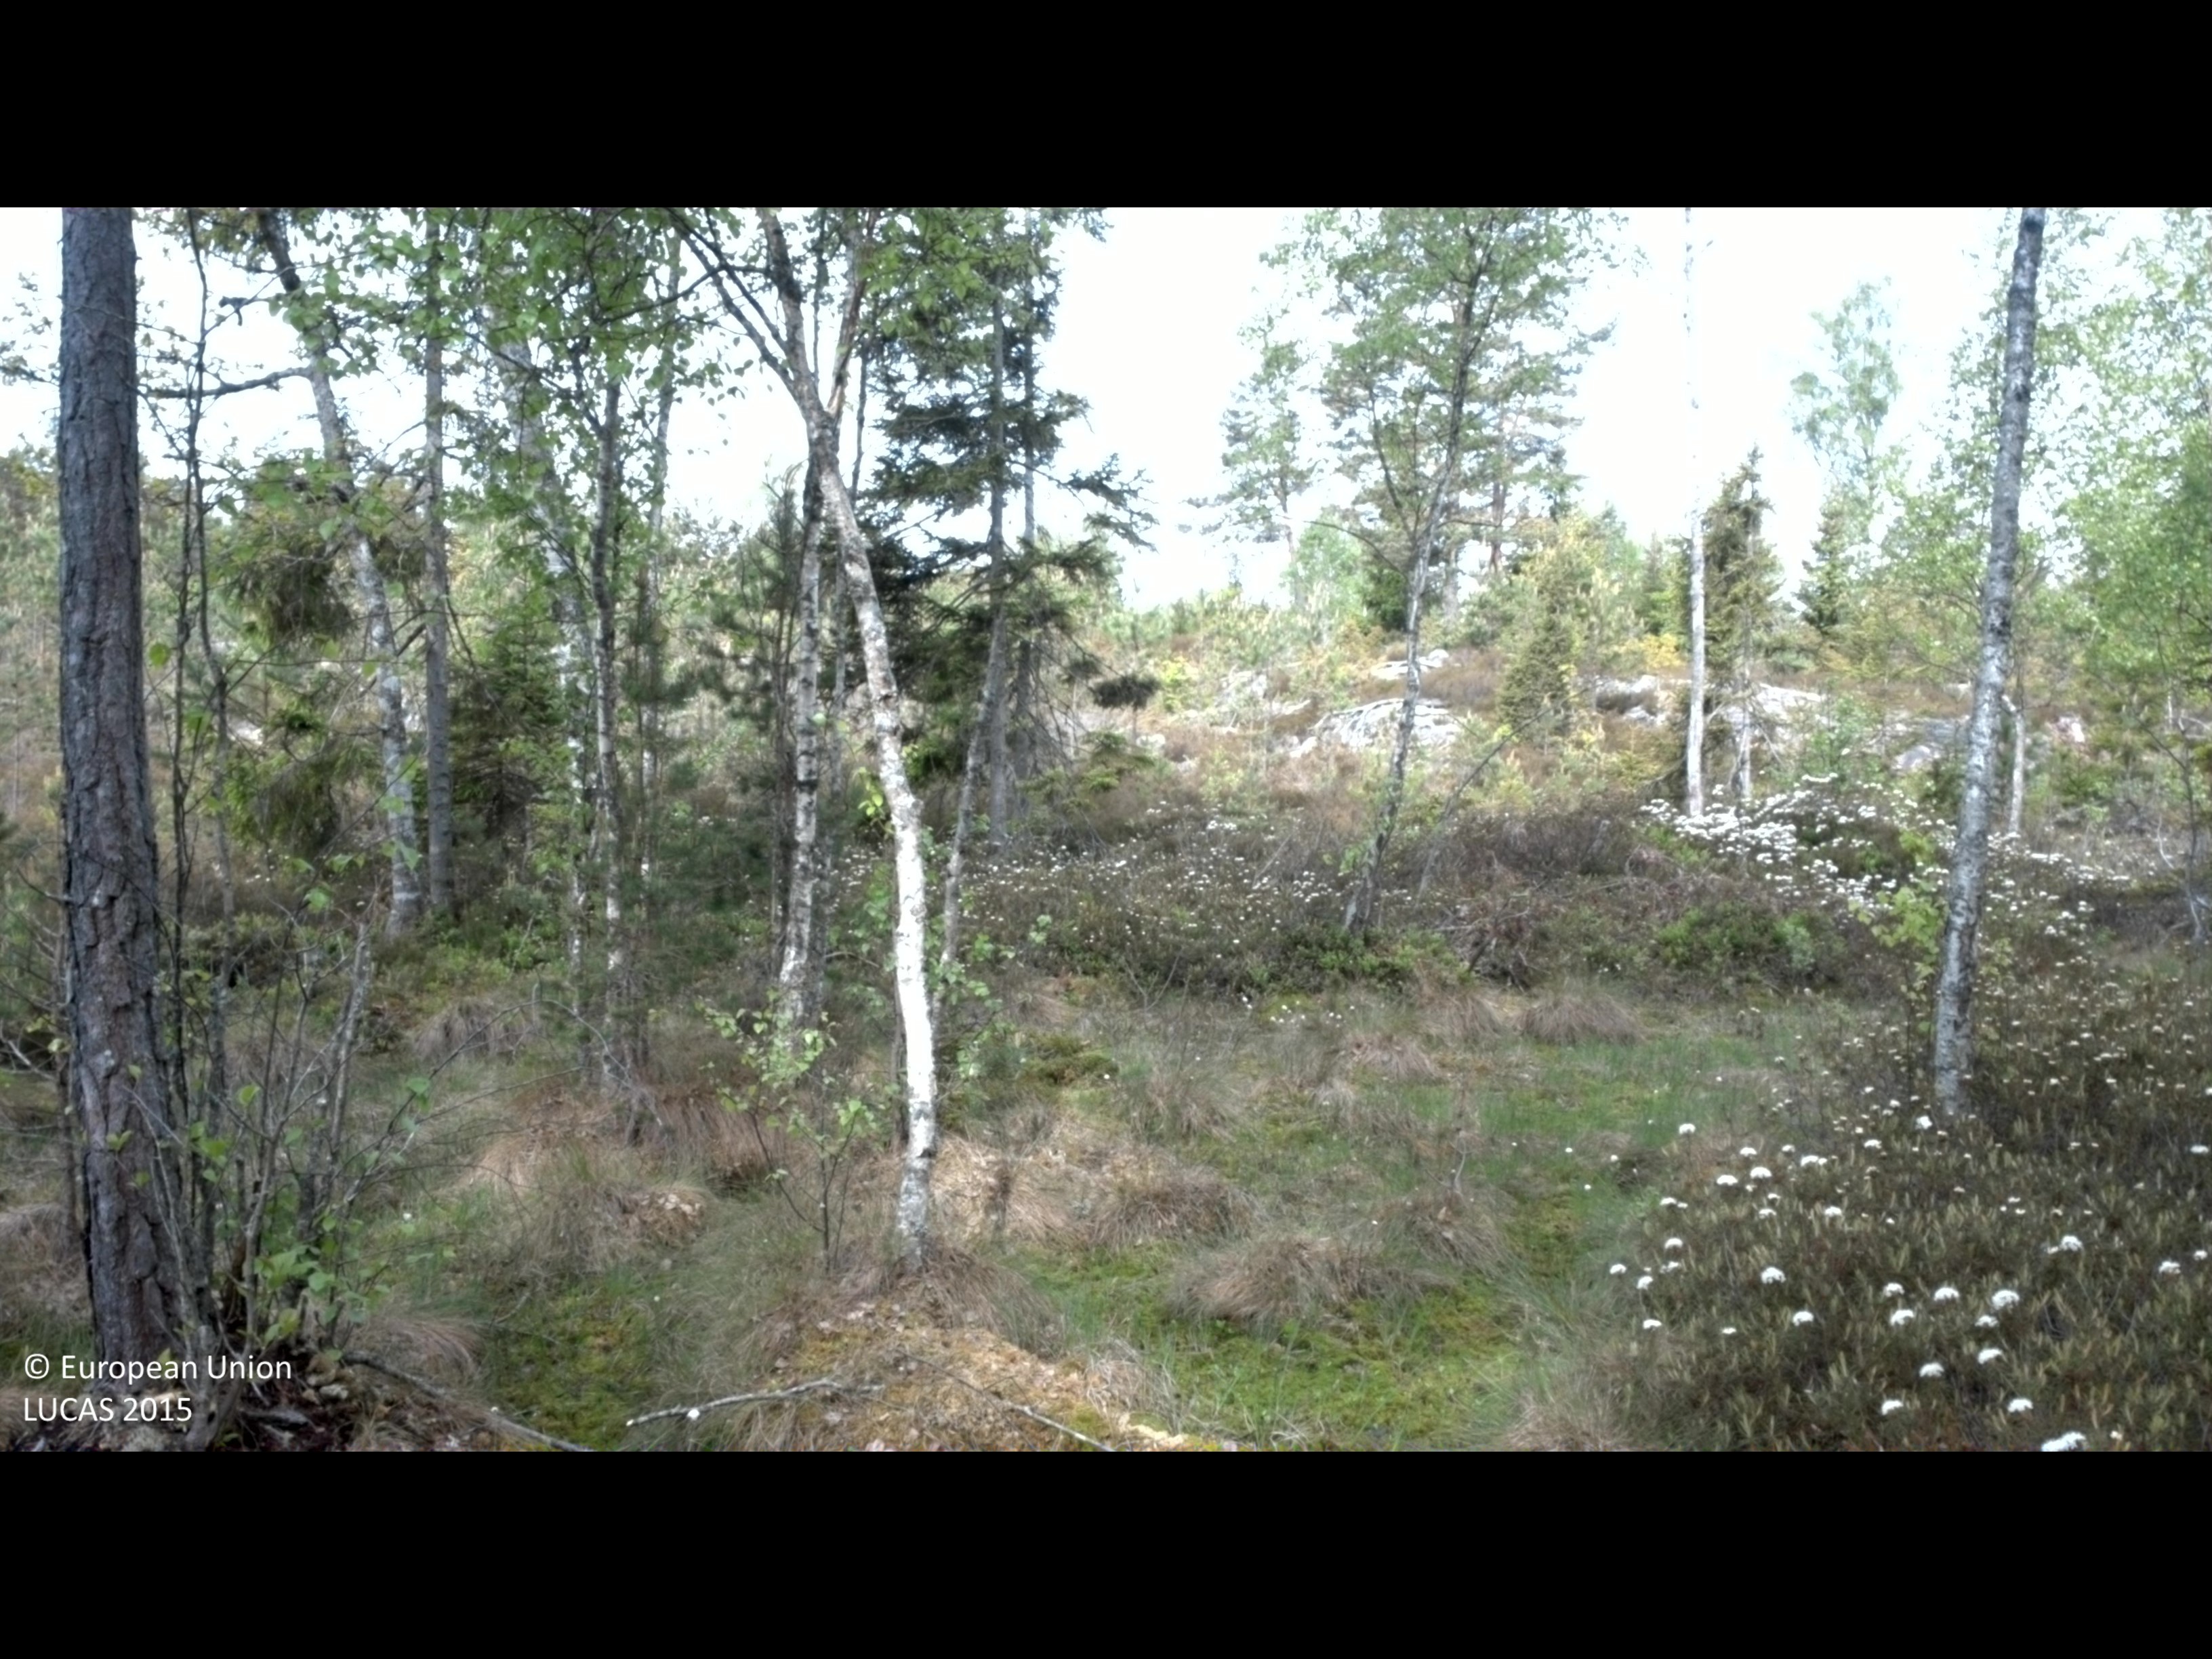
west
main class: Woodland
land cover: Pine dominated mixed woodland
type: boreal forest
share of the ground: > 75 %
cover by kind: coniferous forest trees 60 %, broadleaved forest trees 25 %, shrubs 15 %
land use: Forestry
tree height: > 5 m
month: May
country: SE
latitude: 57.3242
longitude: 16.4598
